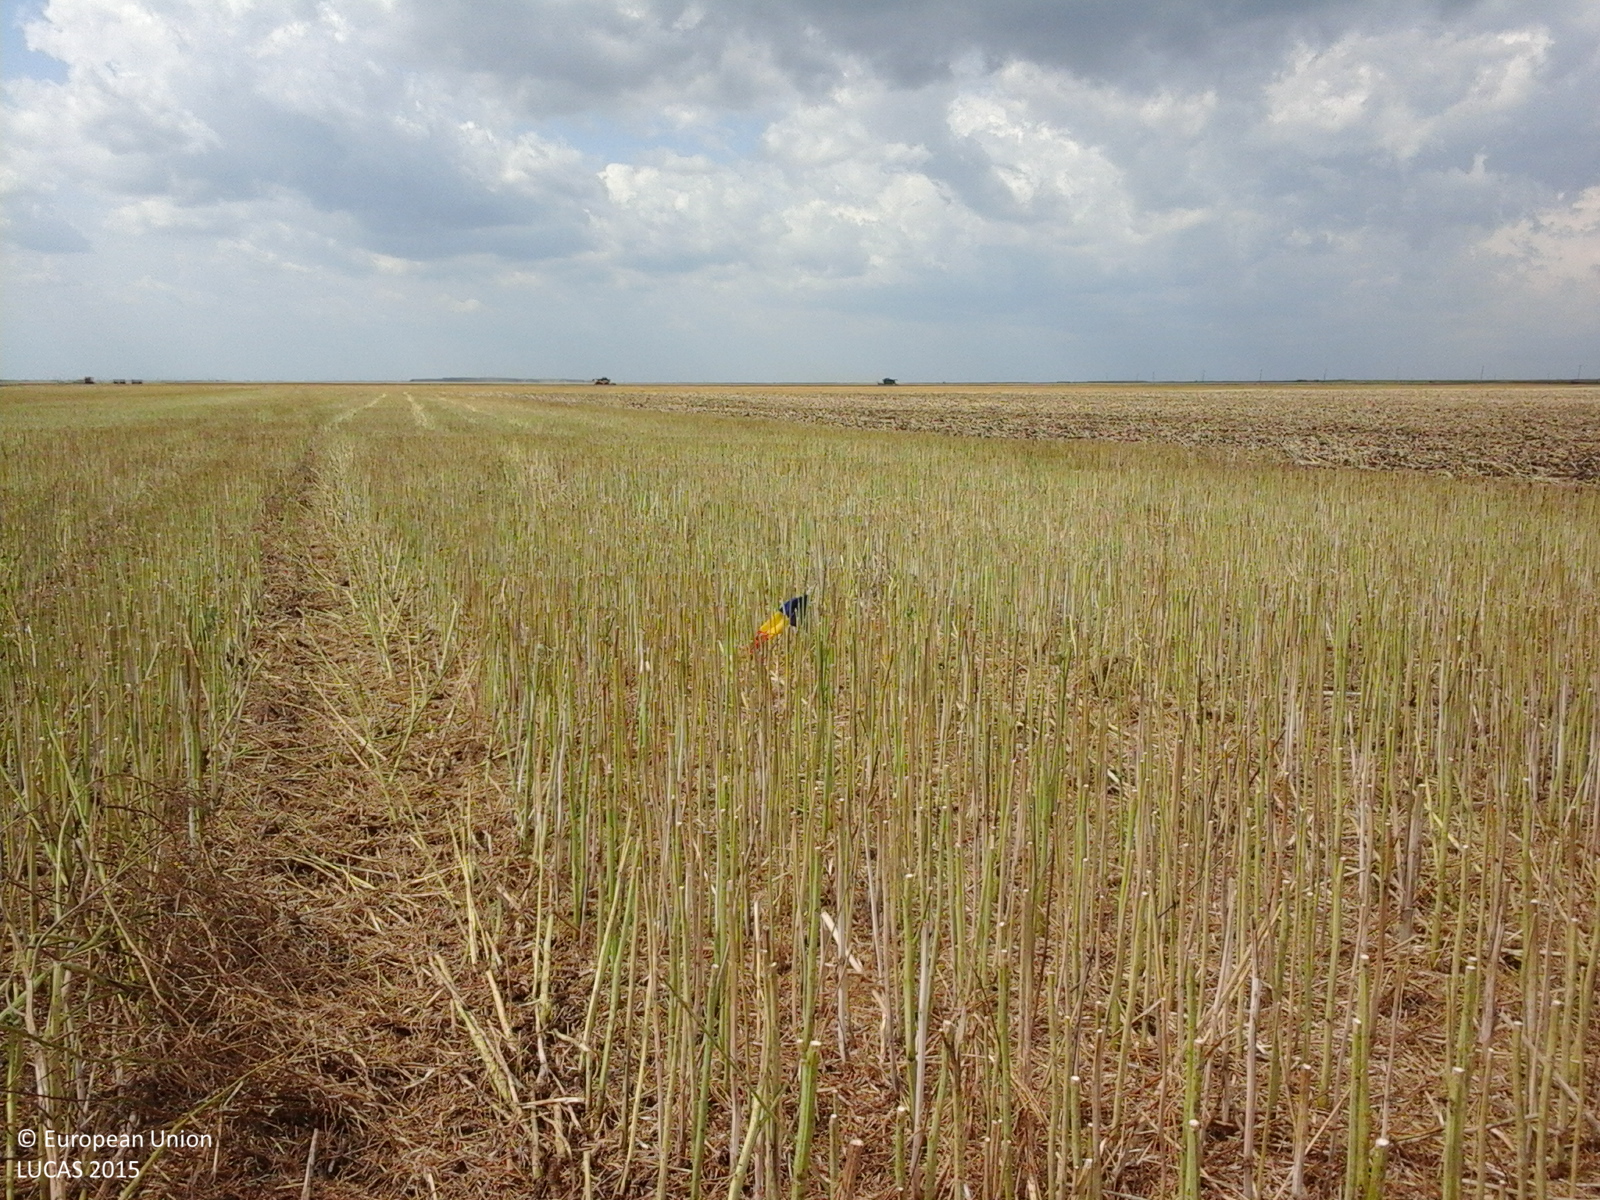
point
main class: Cropland
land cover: Rape and turnip rape
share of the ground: < 10 %
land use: Agriculture (excluding fallow land and kitchen gardens)
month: July
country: RO
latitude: 43.8871
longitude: 24.5424
